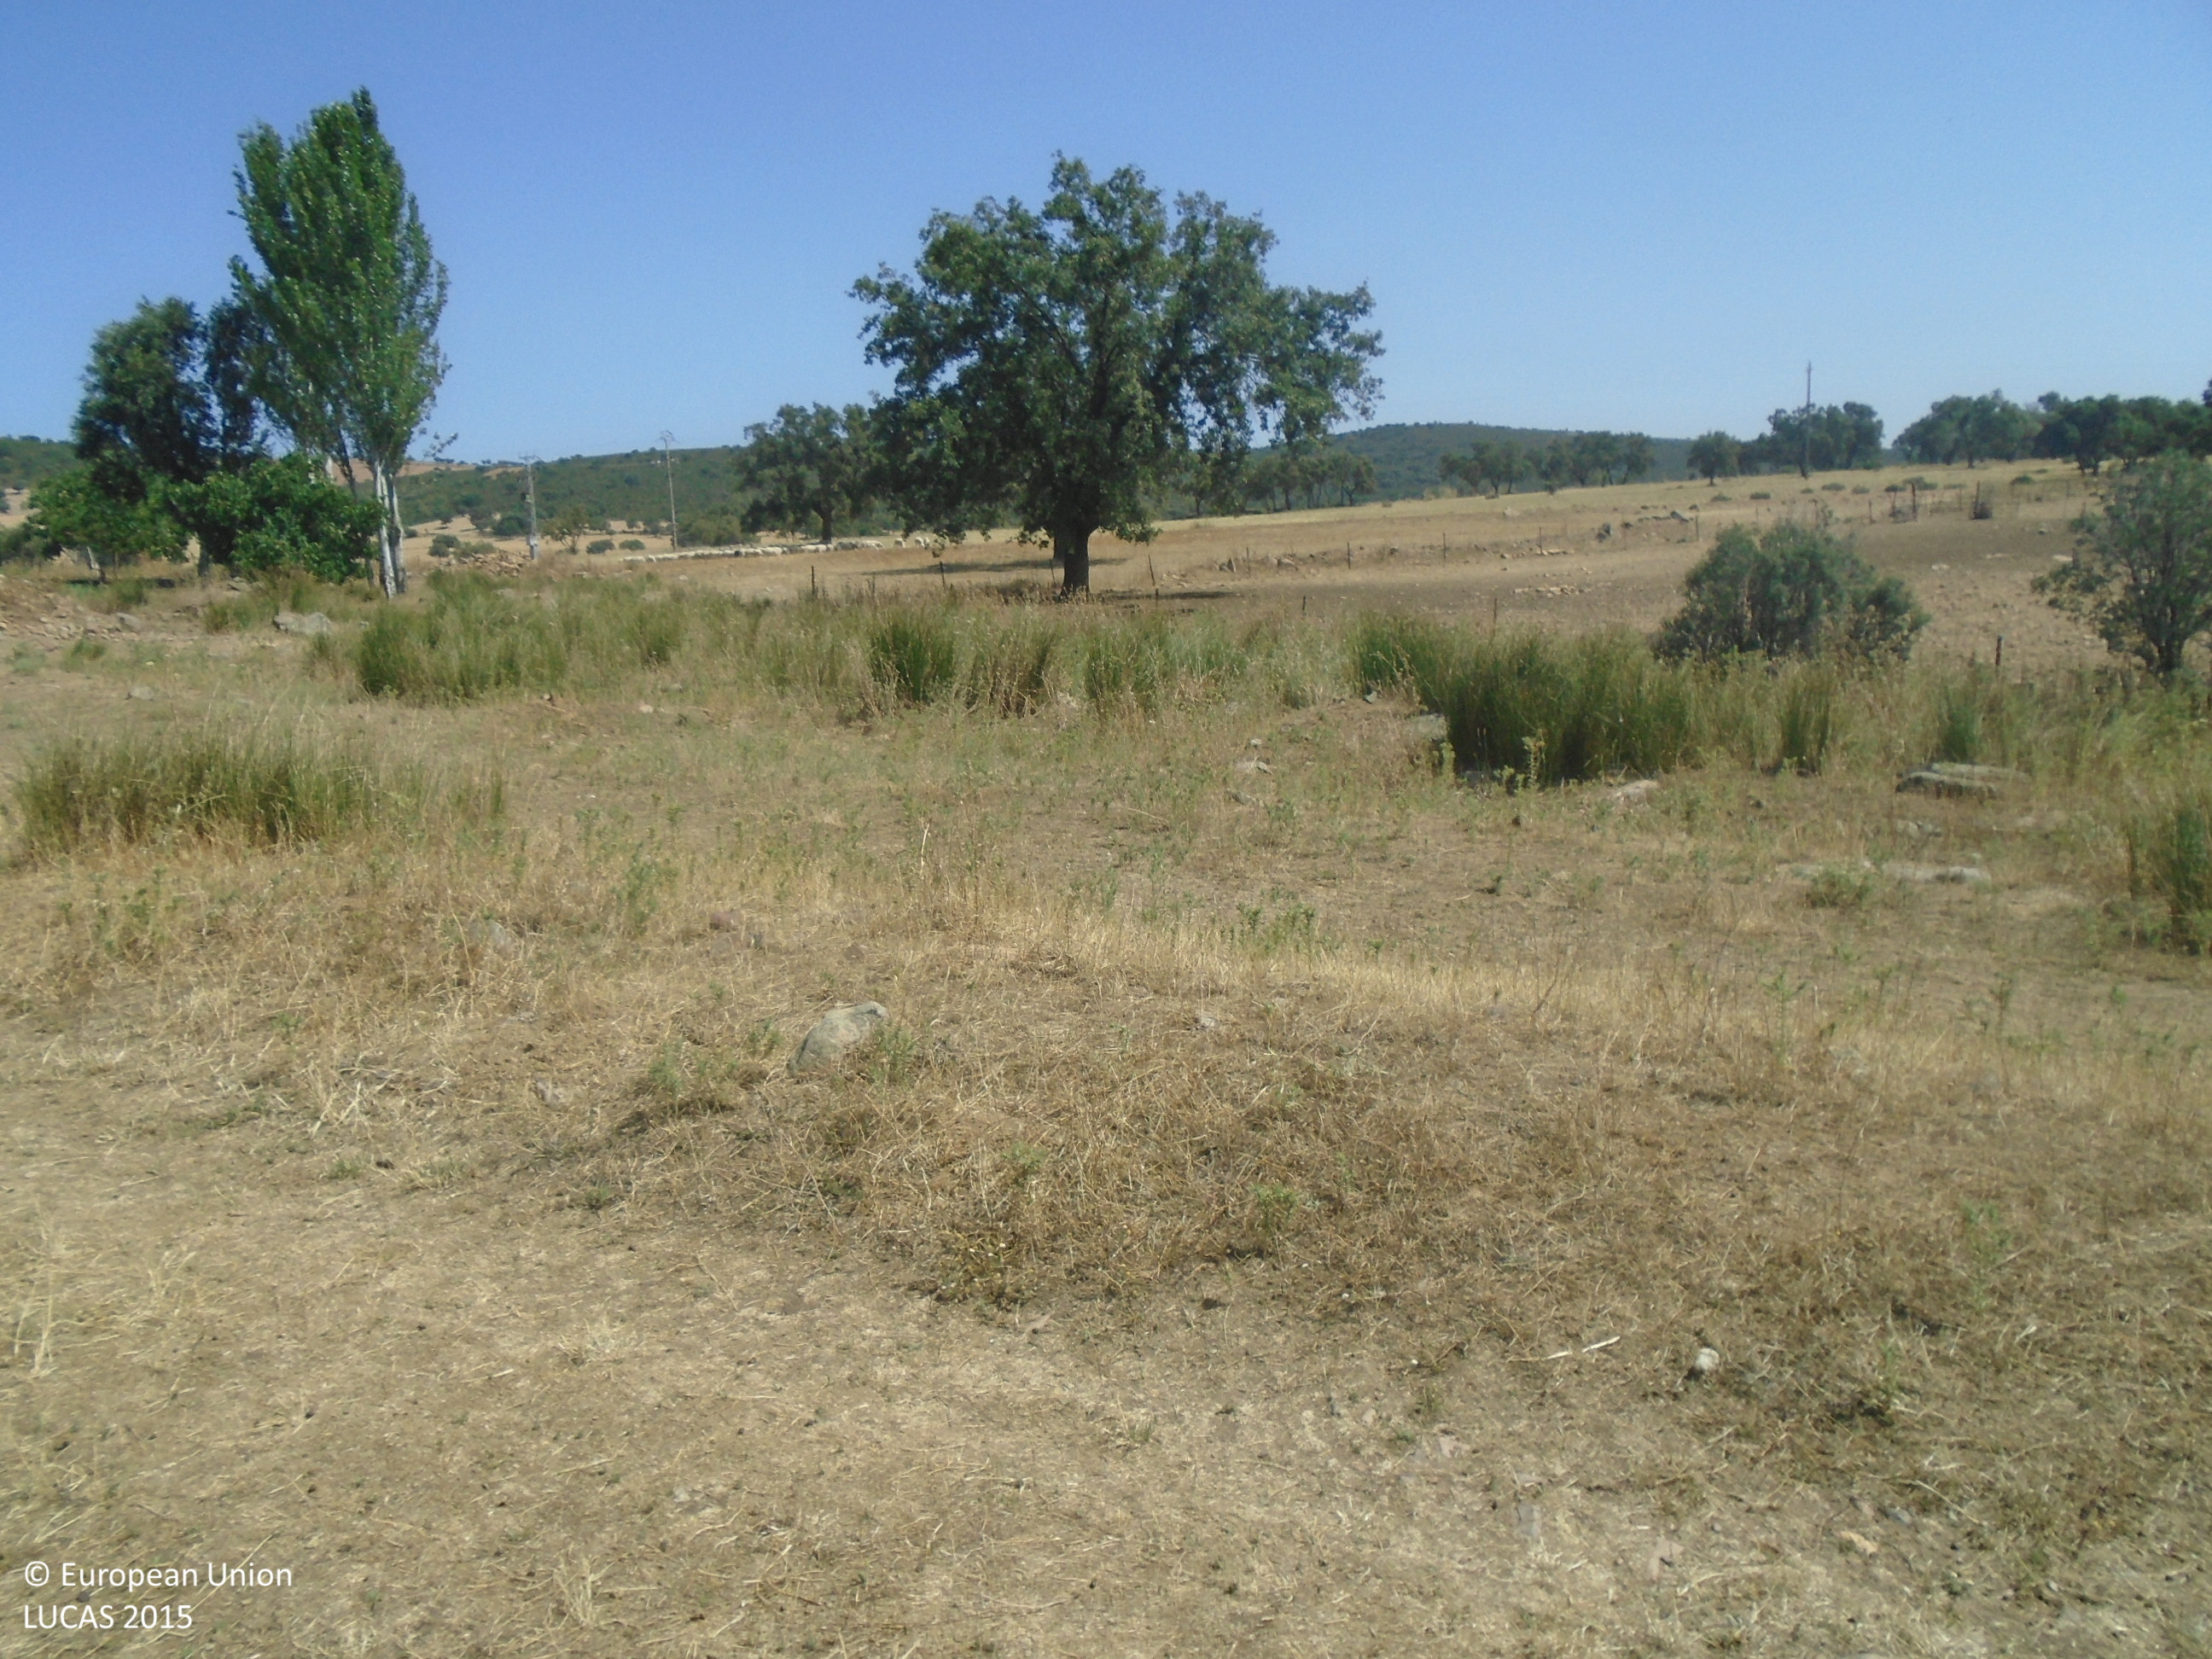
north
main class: Grassland
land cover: Spontaneously vegetated surfaces
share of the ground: > 75 %
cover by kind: herbaceous plants 100 %
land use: Semi-natural and natural areas not in use
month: July
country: ES
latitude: 39.3317
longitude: -4.1234
